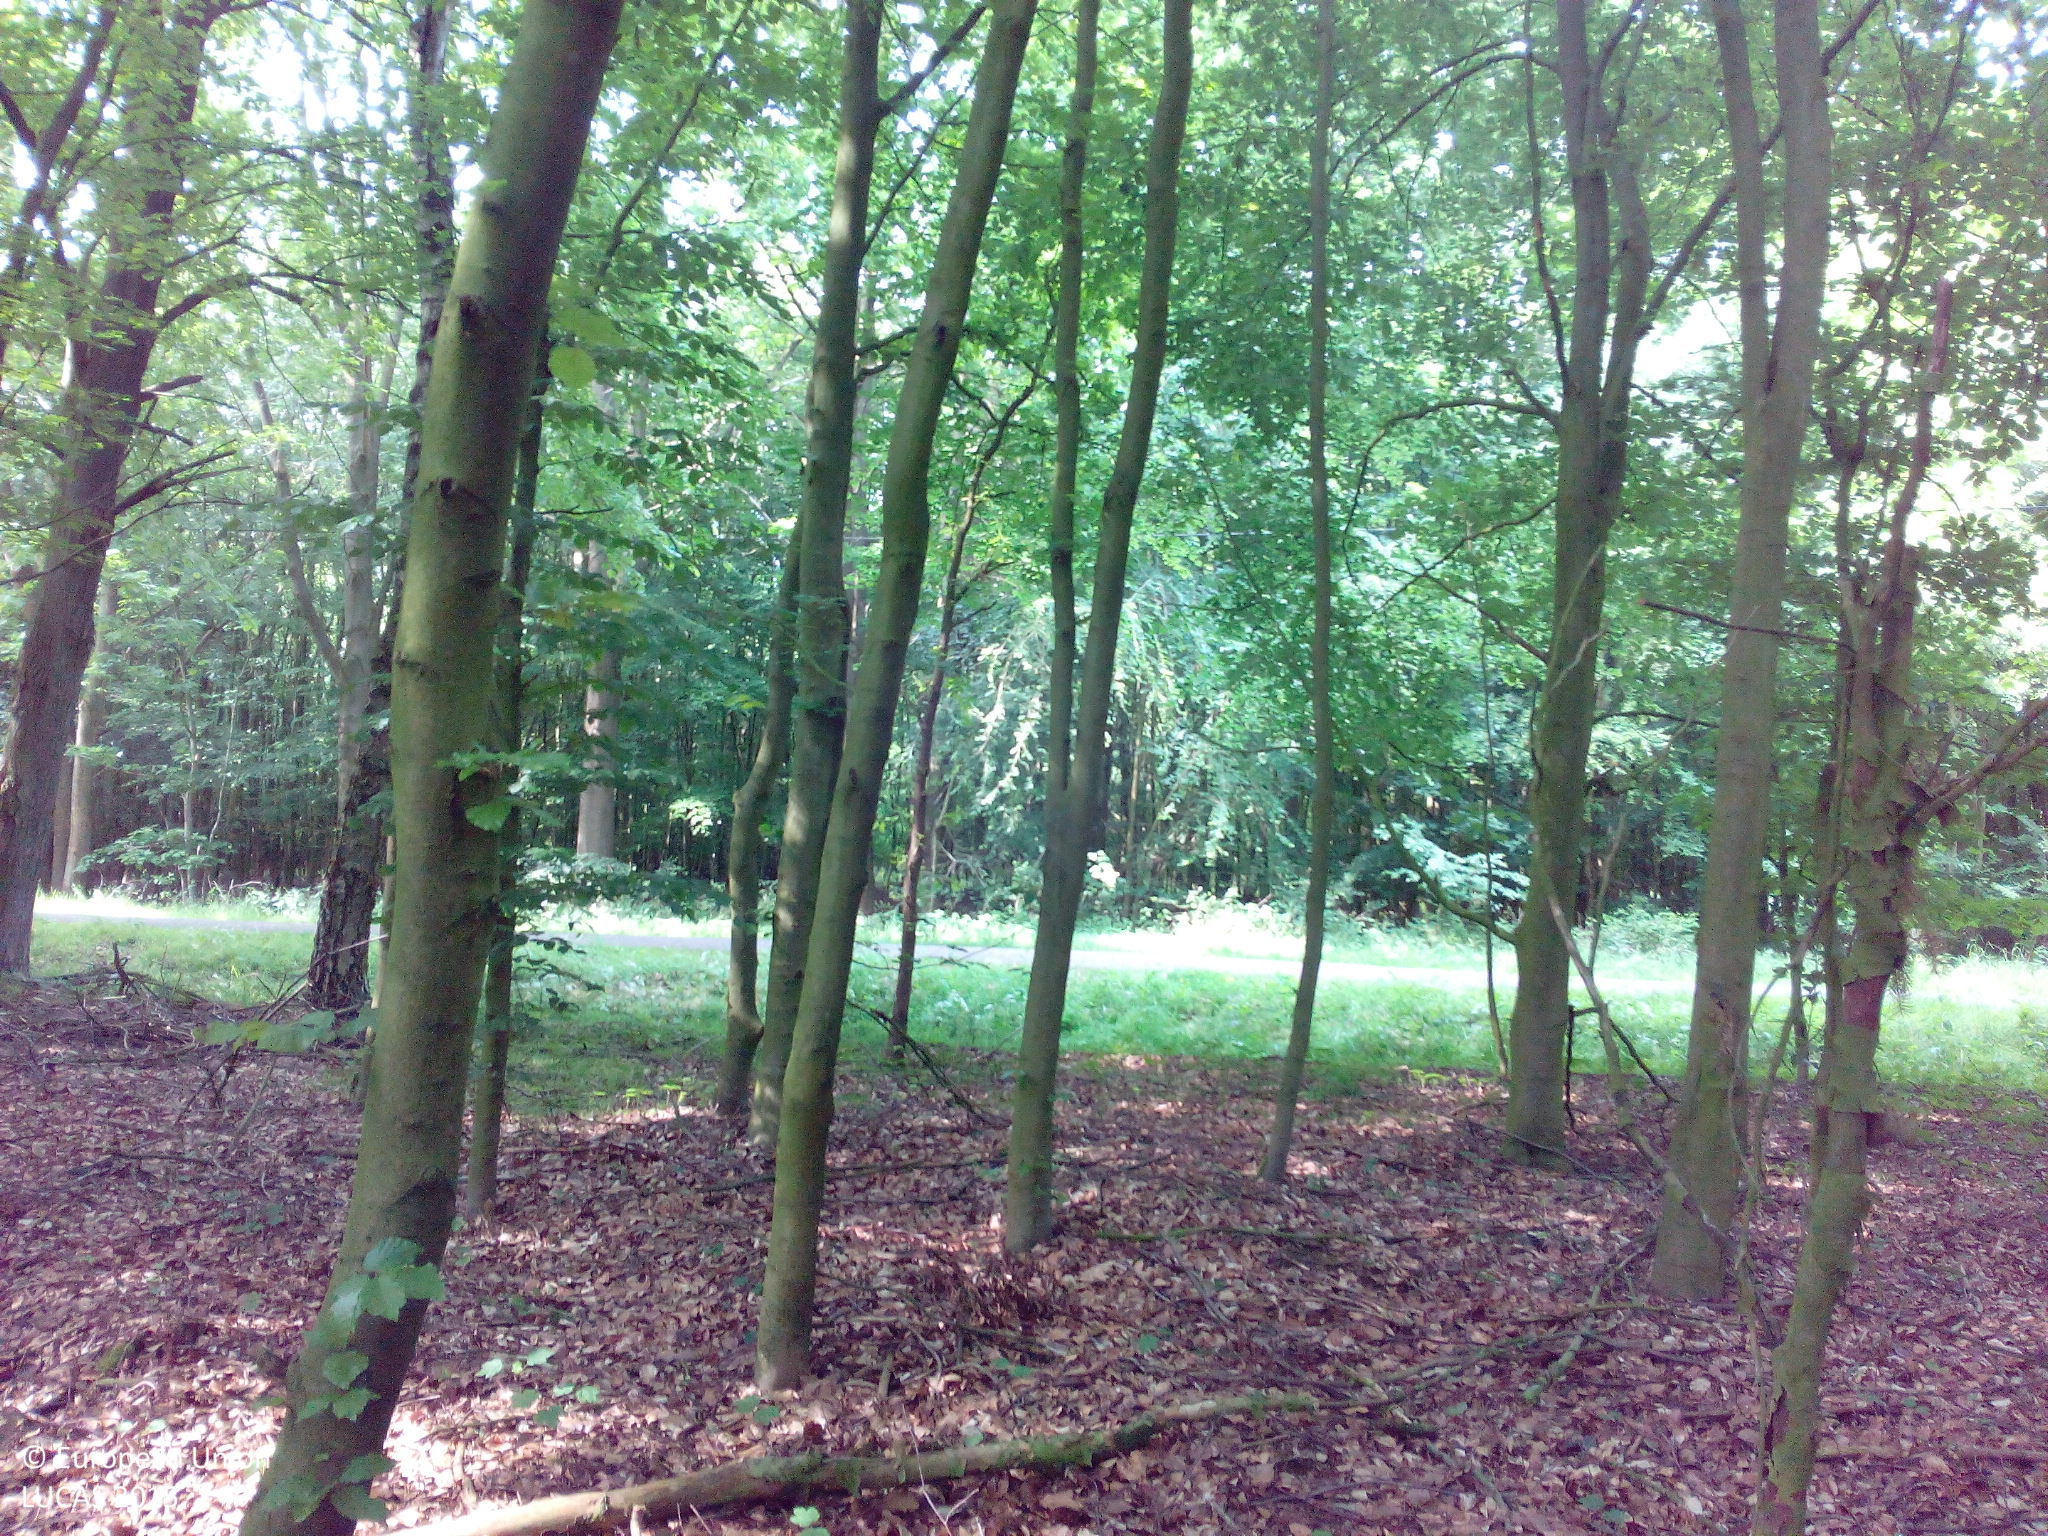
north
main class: Woodland
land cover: Broadleaved woodland
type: mesophytic deciduous forest
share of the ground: > 75 %
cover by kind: broadleaved forest trees 100 %
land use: Forestry
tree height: > 5 m
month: June
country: DE
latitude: 52.3324
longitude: 7.4616
